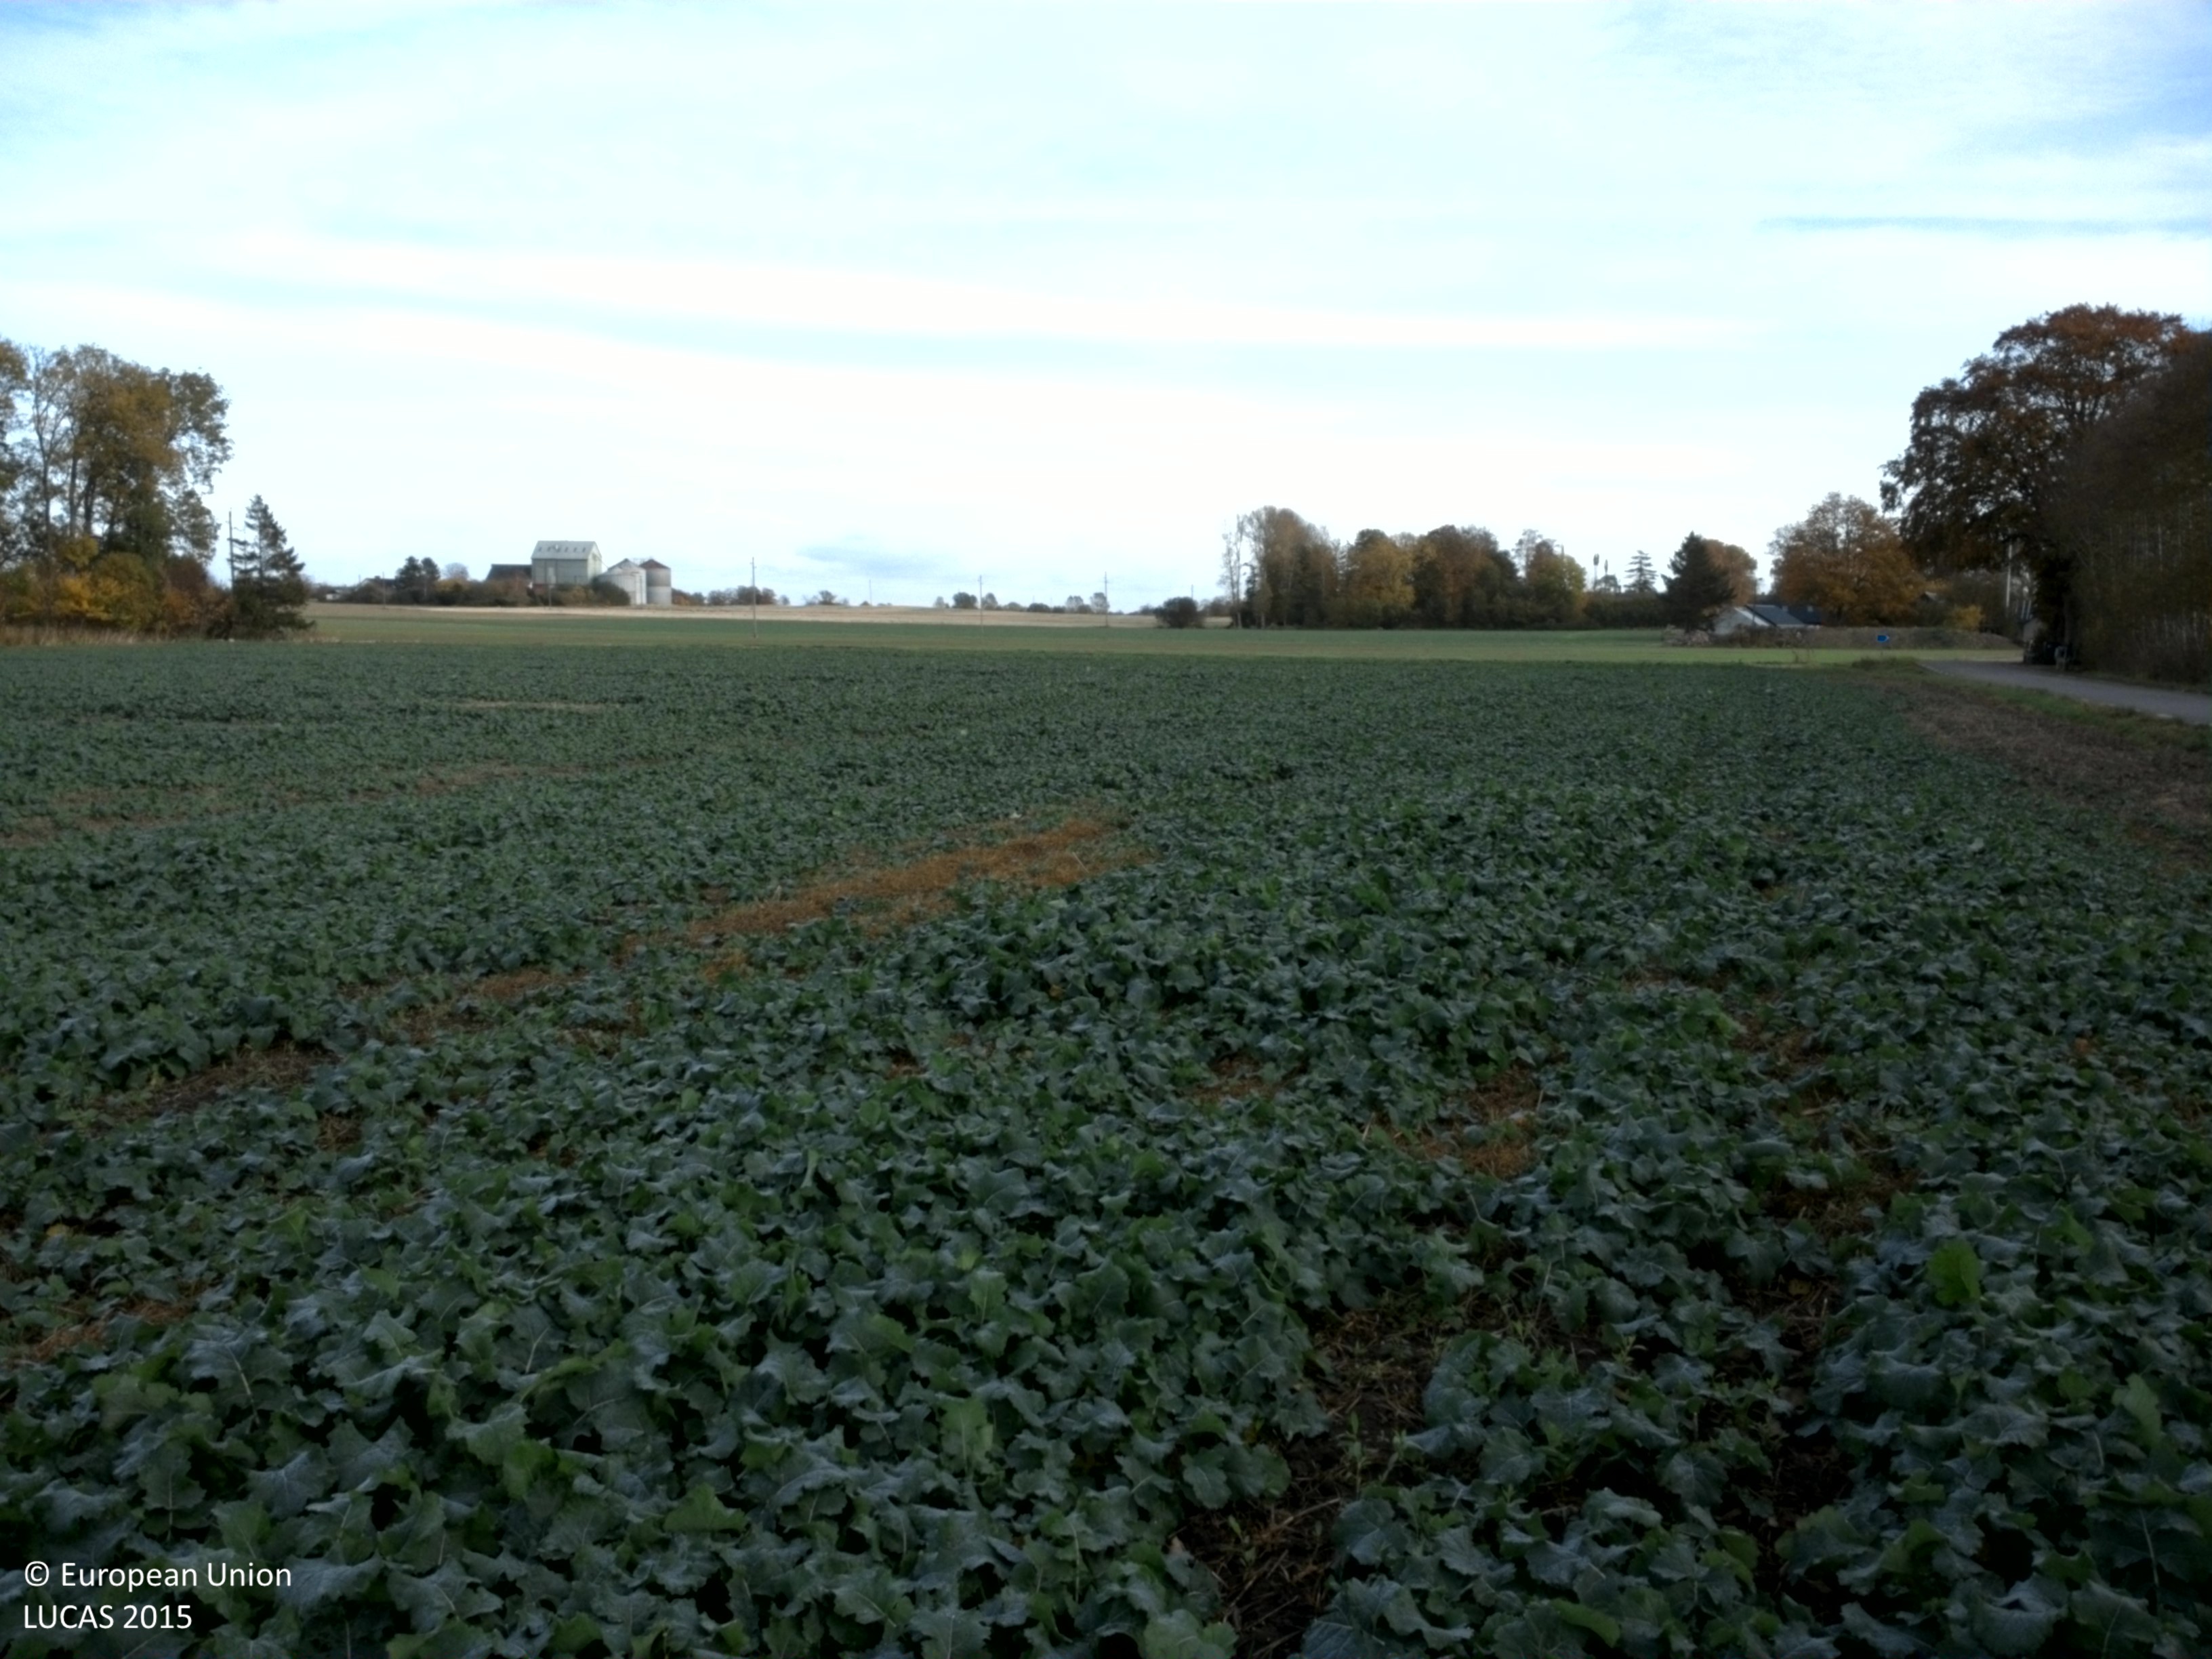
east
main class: Cropland
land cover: Rape and turnip rape
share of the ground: 50 - 75 %
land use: Agriculture (excluding fallow land and kitchen gardens)
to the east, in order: Rape and turnip rape; Grass margins; Common wheat
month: October
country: SE
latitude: 55.9587
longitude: 12.8328
